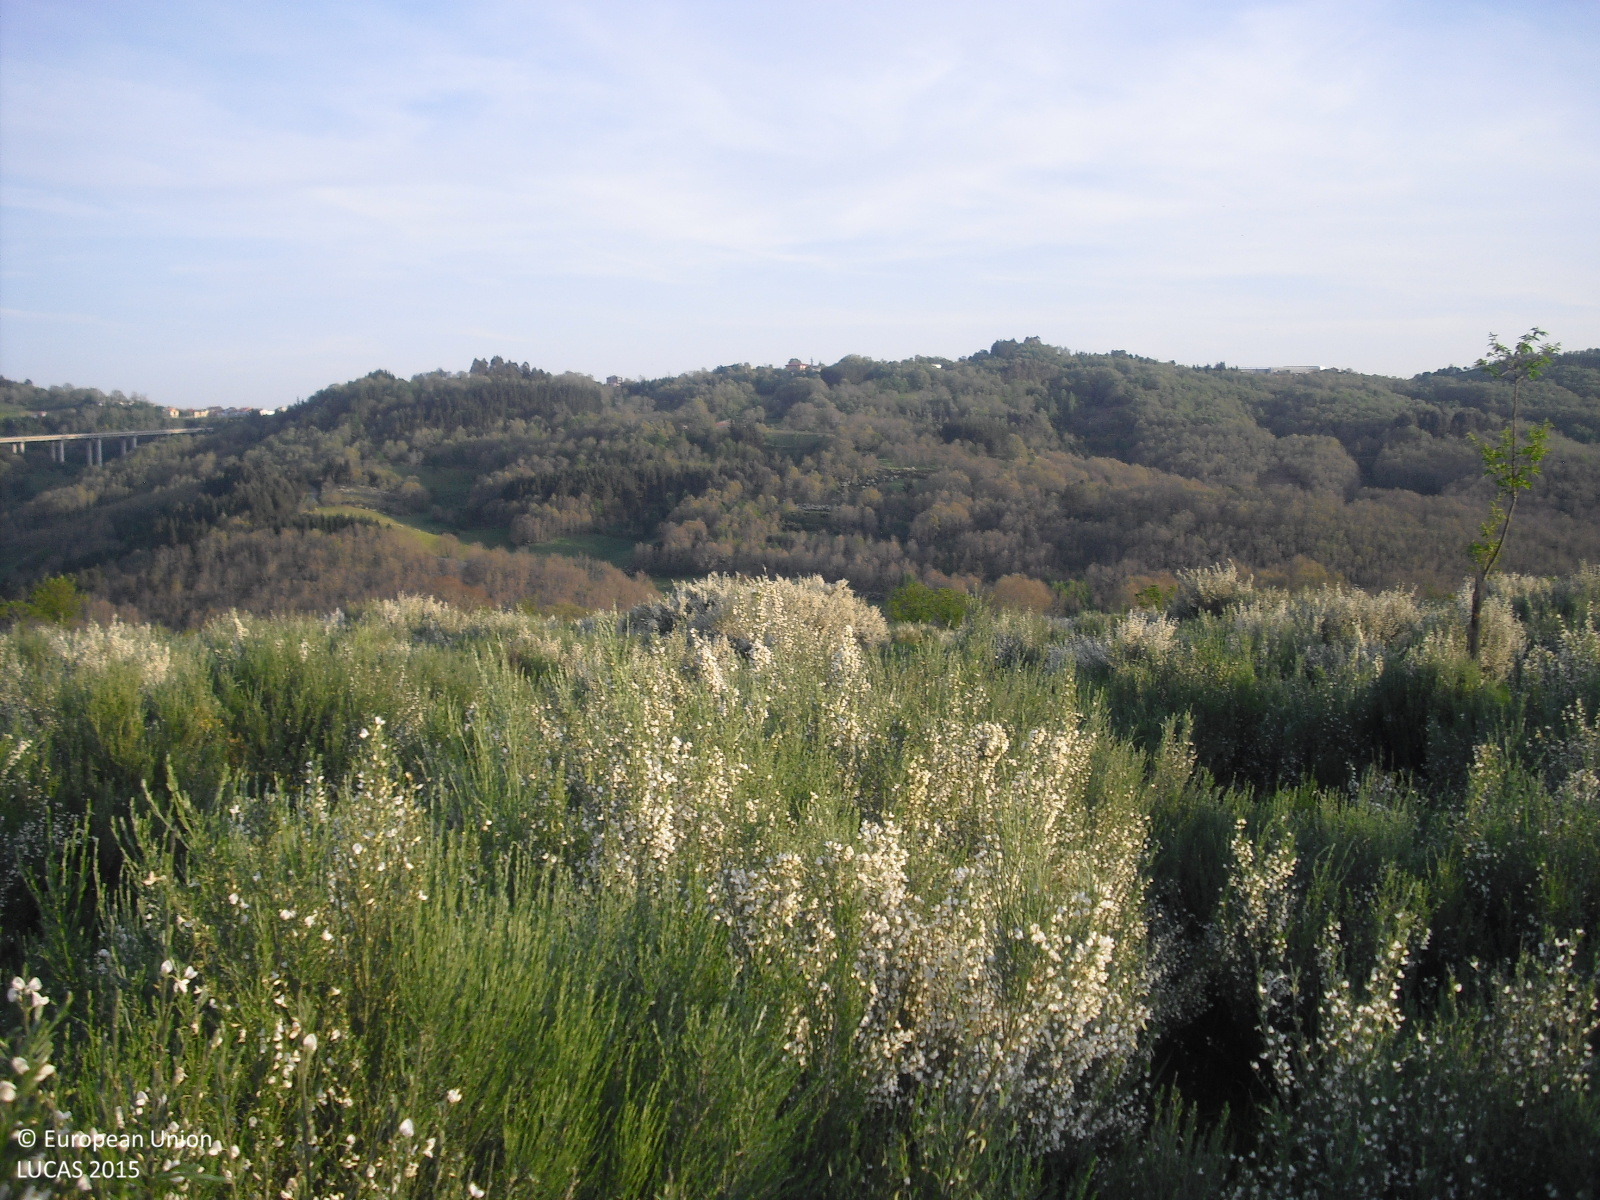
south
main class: Shrubland
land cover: Shrubland without tree cover
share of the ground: > 75 %
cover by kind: shrubs 80 %, herbaceous plants 20 %
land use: Abandoned areas
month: May
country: ES
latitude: 42.0022
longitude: -7.2853
